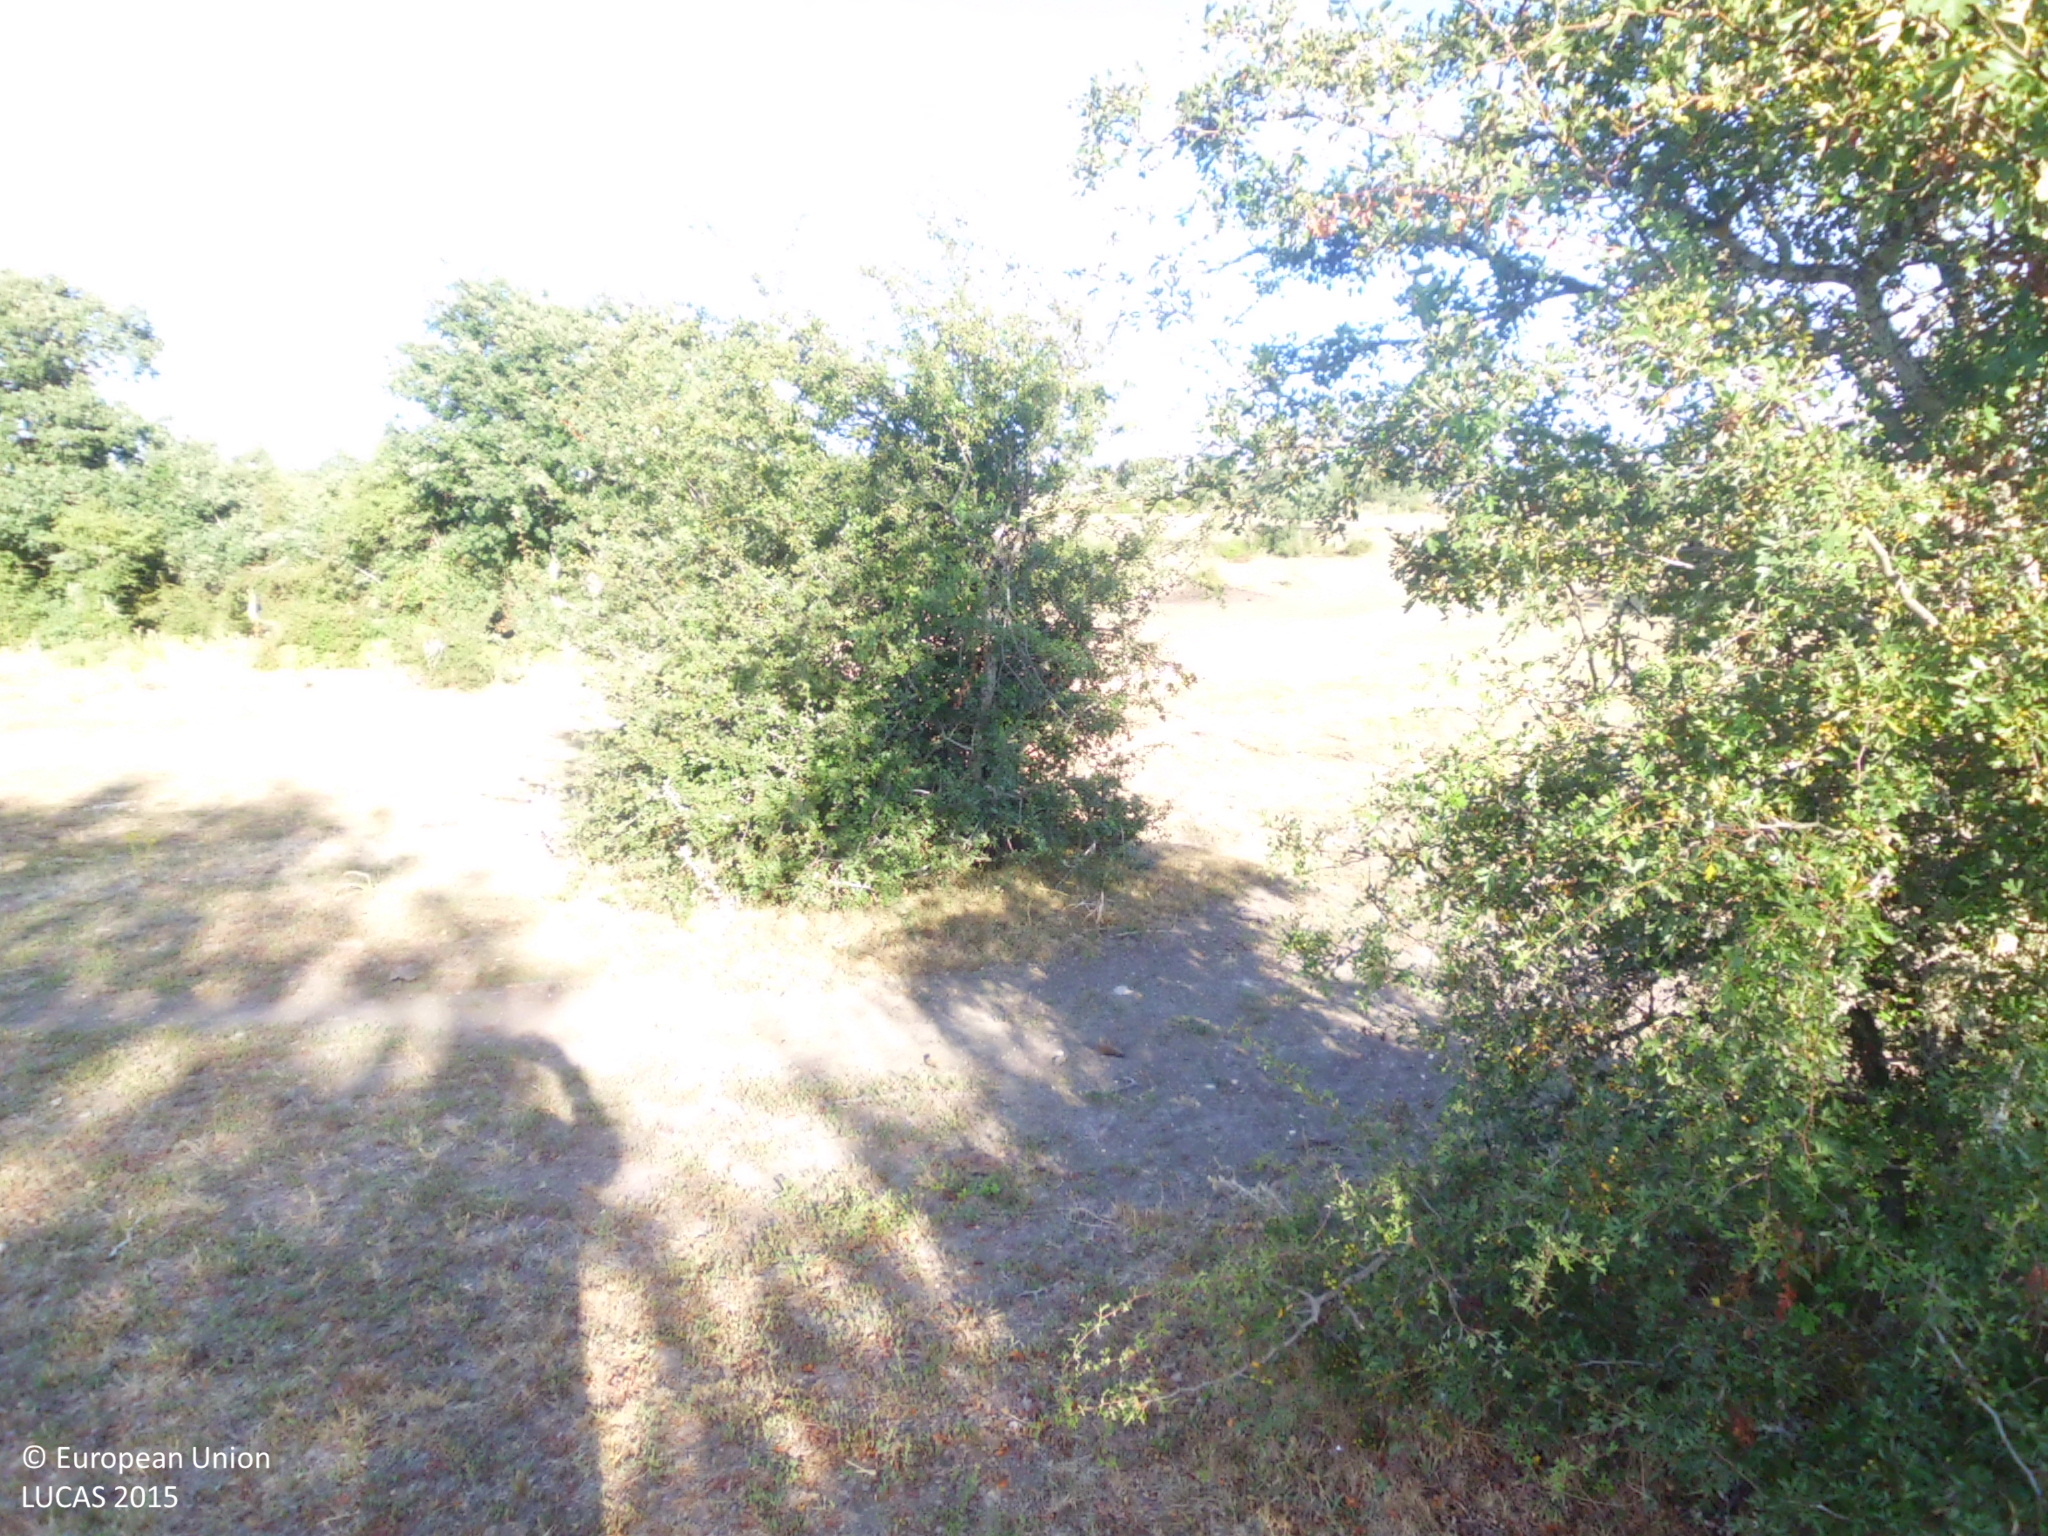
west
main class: Grassland
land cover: Grassland with sparse tree/shrub cover
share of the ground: 25 - 50 %
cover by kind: unconsolidated bare surface 50 %, herbaceous plants 40 %, broadleaved forest trees 5 %, shrubs 5 %
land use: Agriculture (excluding fallow land and kitchen gardens)
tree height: < 5 m
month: July
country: ES
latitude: 42.6995
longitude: -4.2709
